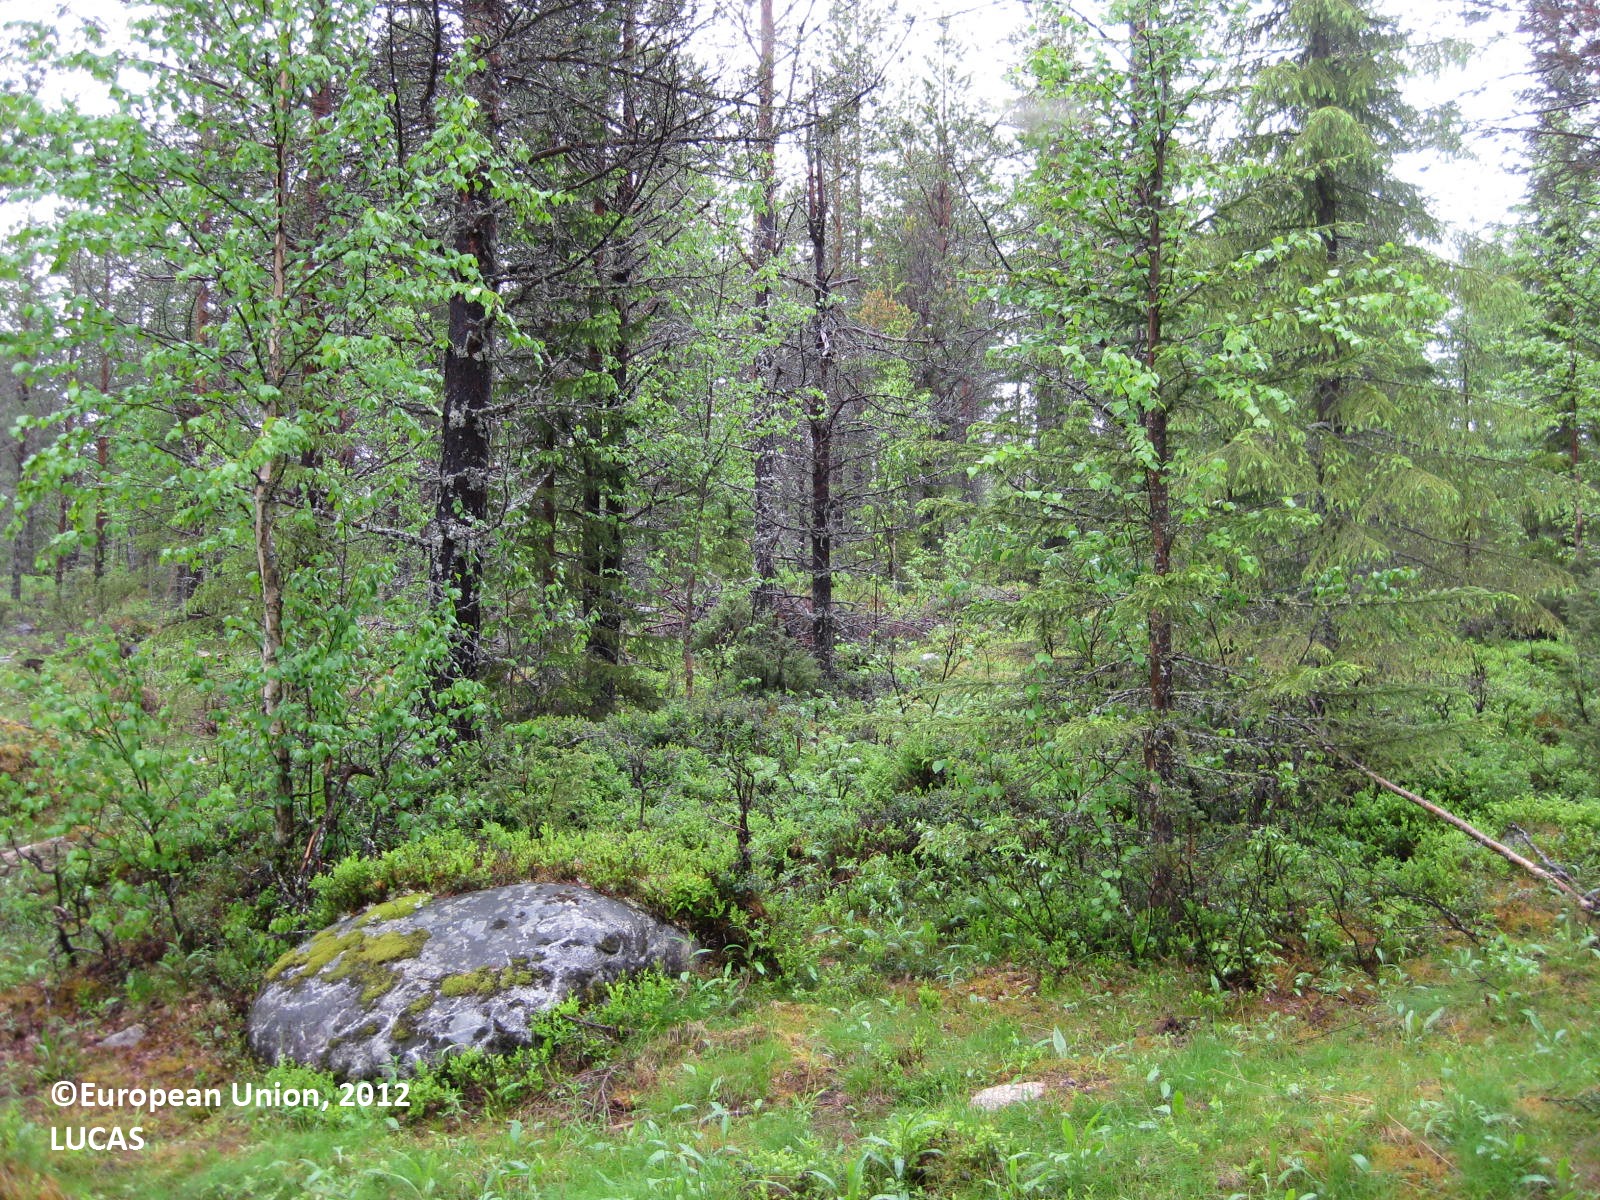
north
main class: Woodland
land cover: Other coniferous woodland
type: boreal forest
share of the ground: > 75 %
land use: Forestry
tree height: > 5 m
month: June
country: FI
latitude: 65.1501
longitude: 28.9278
